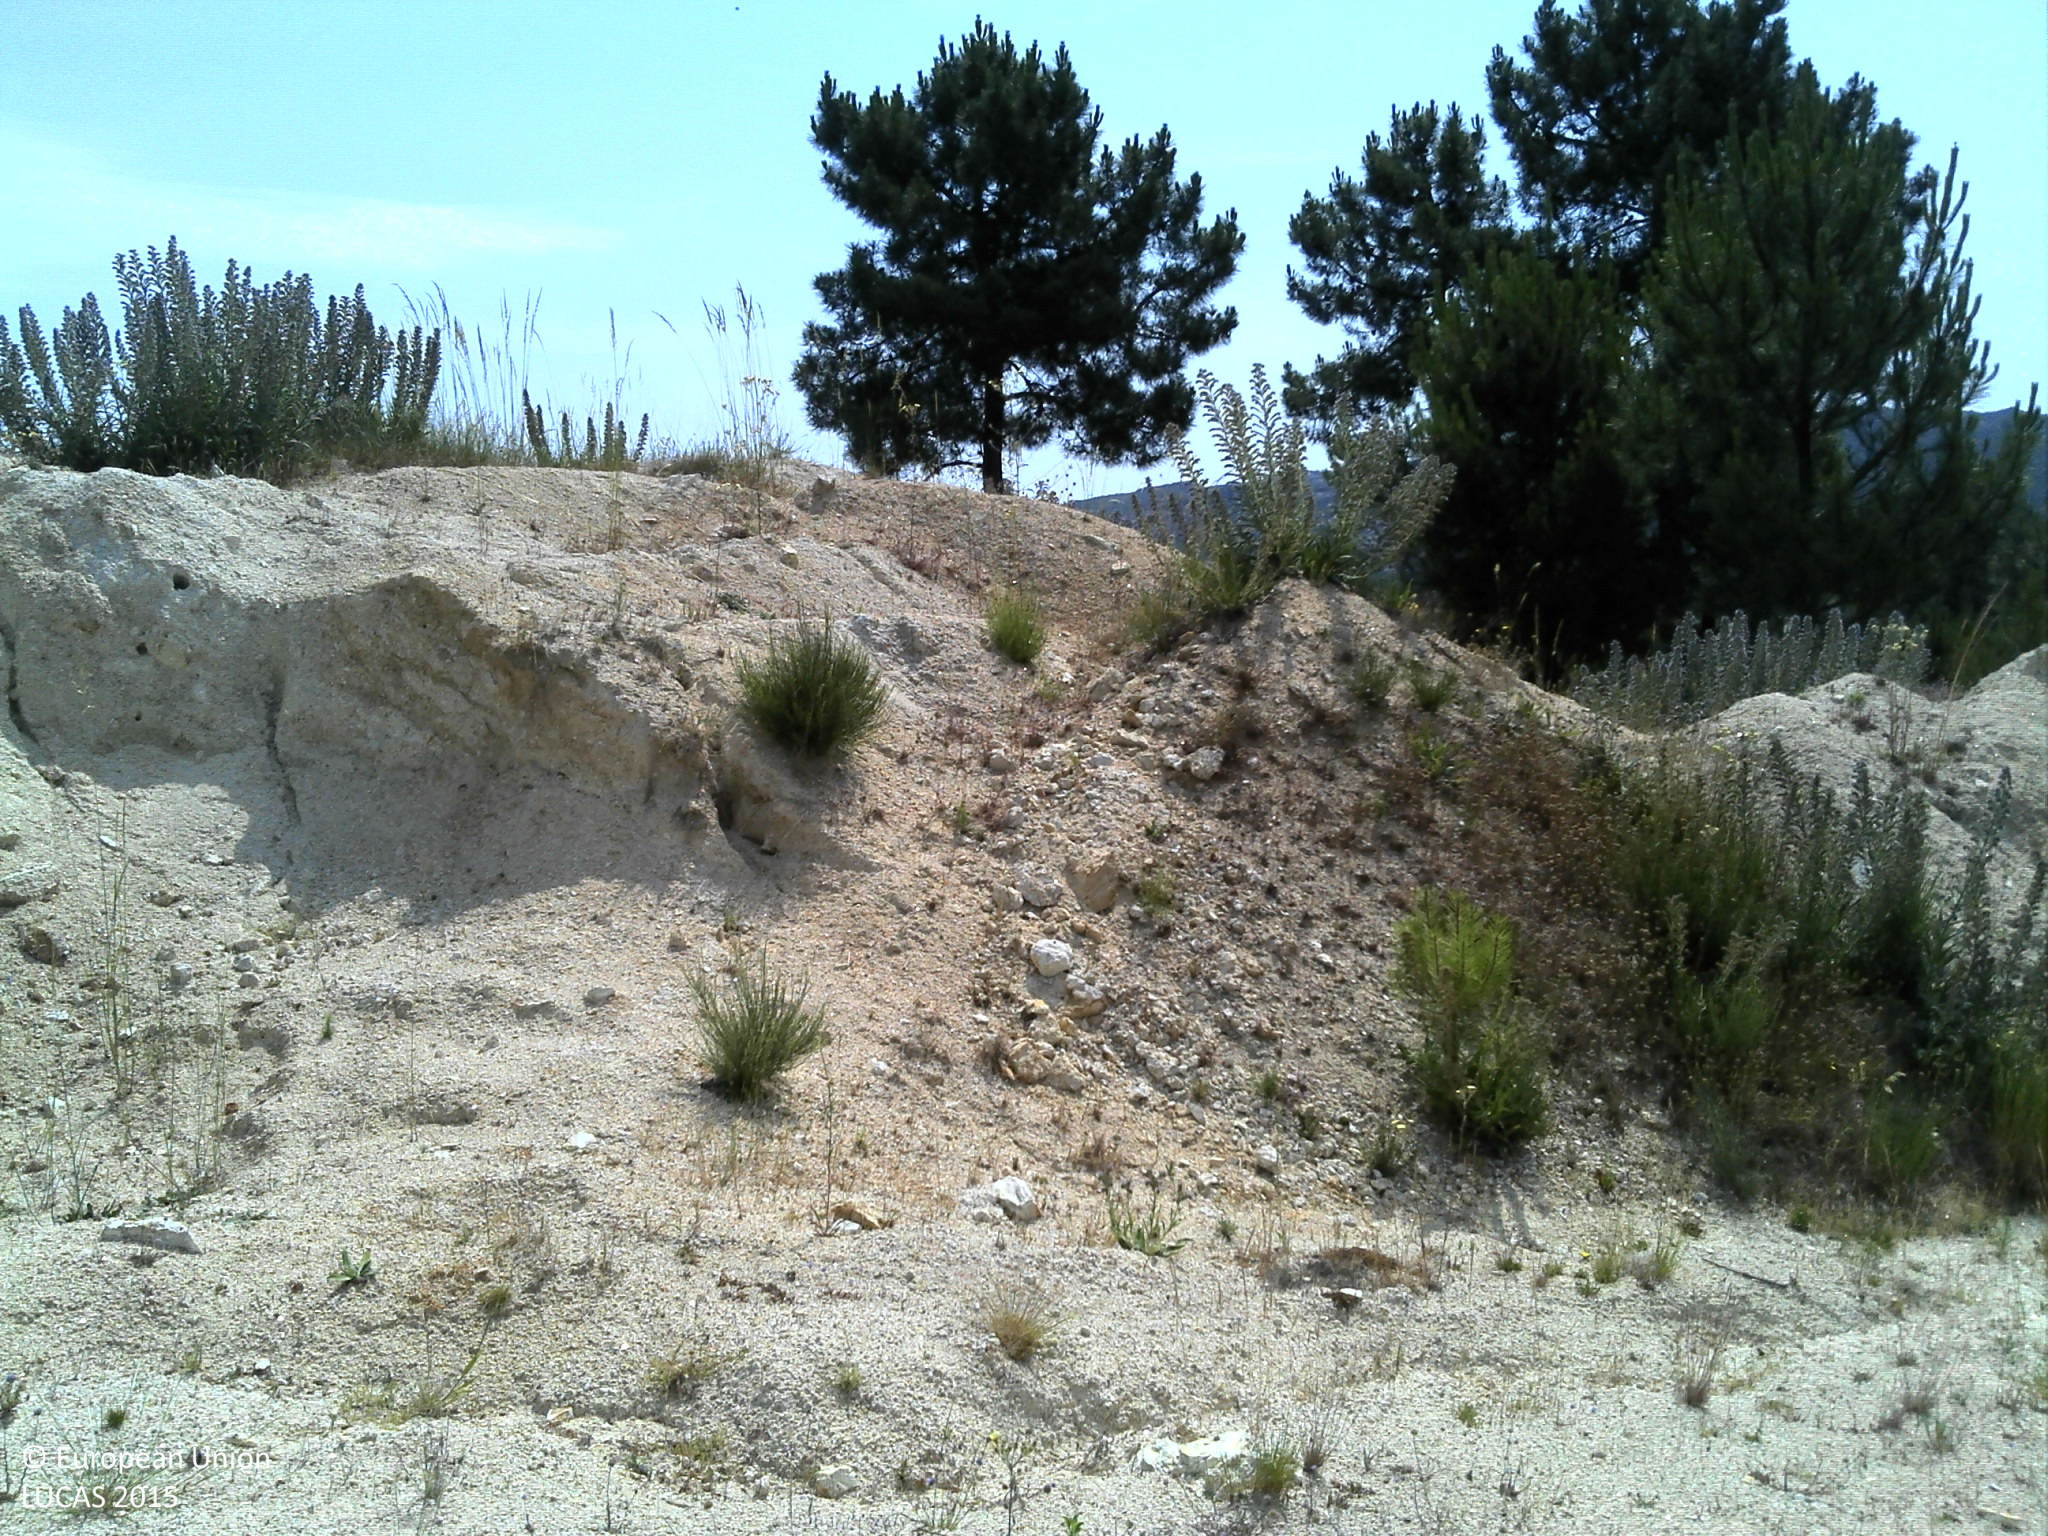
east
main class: Shrubland
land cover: Shrubland with sparse tree cover
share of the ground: 50 - 75 %
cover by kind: shrubs 70 %, unconsolidated bare surface 25 %, coniferous forest trees 5 %
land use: Semi-natural and natural areas not in use
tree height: > 5 m
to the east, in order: Shrubland with sparse tree cover; Shrubland without tree cover; Shrubland with sparse tree cover; Nuts trees; Shrubland with sparse tree cover; Pine dominated coniferous woodland; Shrubland with sparse tree cover; Dry stone walls; Grassland with sparse tree/shrub cover
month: June
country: PT
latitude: 41.4192
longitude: -7.5600
